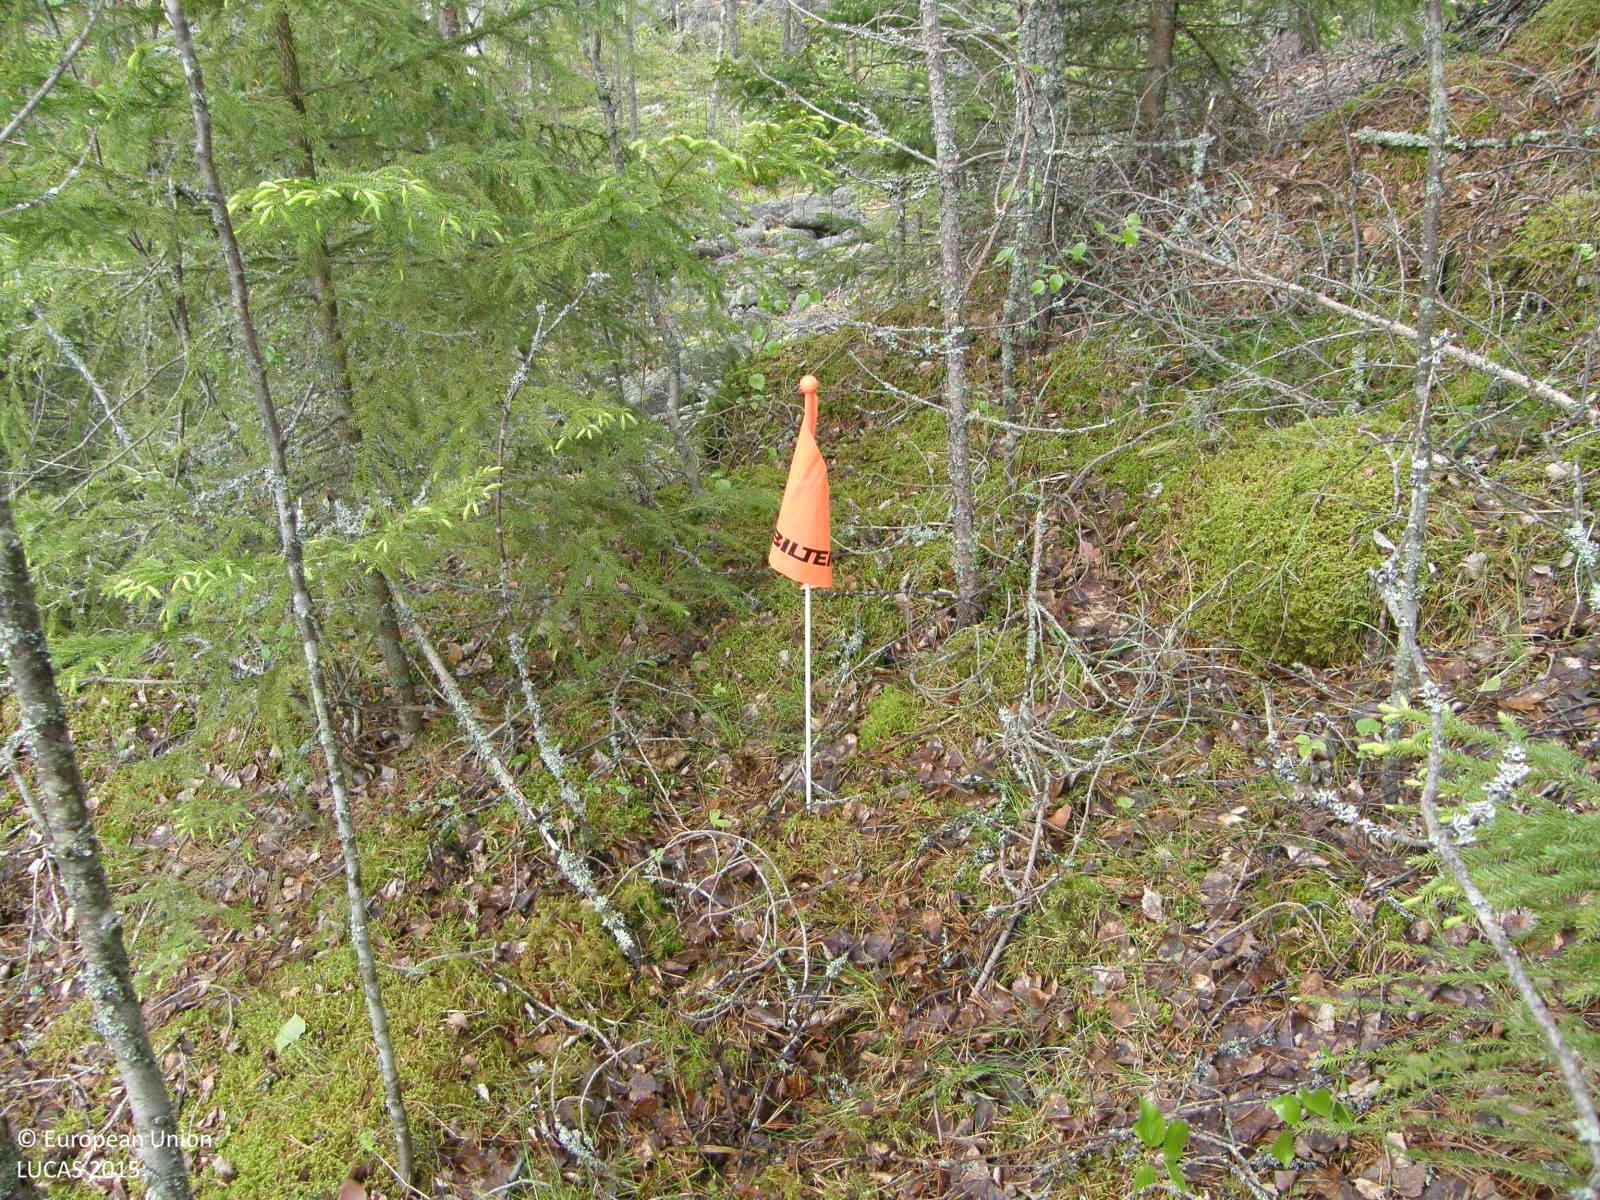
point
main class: Woodland
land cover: Pine dominated mixed woodland
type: boreal forest
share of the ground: > 75 %
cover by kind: coniferous forest trees 65 %, broadleaved forest trees 25 %, consolidated bare surface 5 %, unconsolidated bare surface 5 %
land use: Forestry
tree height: > 5 m
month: June
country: FI
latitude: 61.9391
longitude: 21.6542
